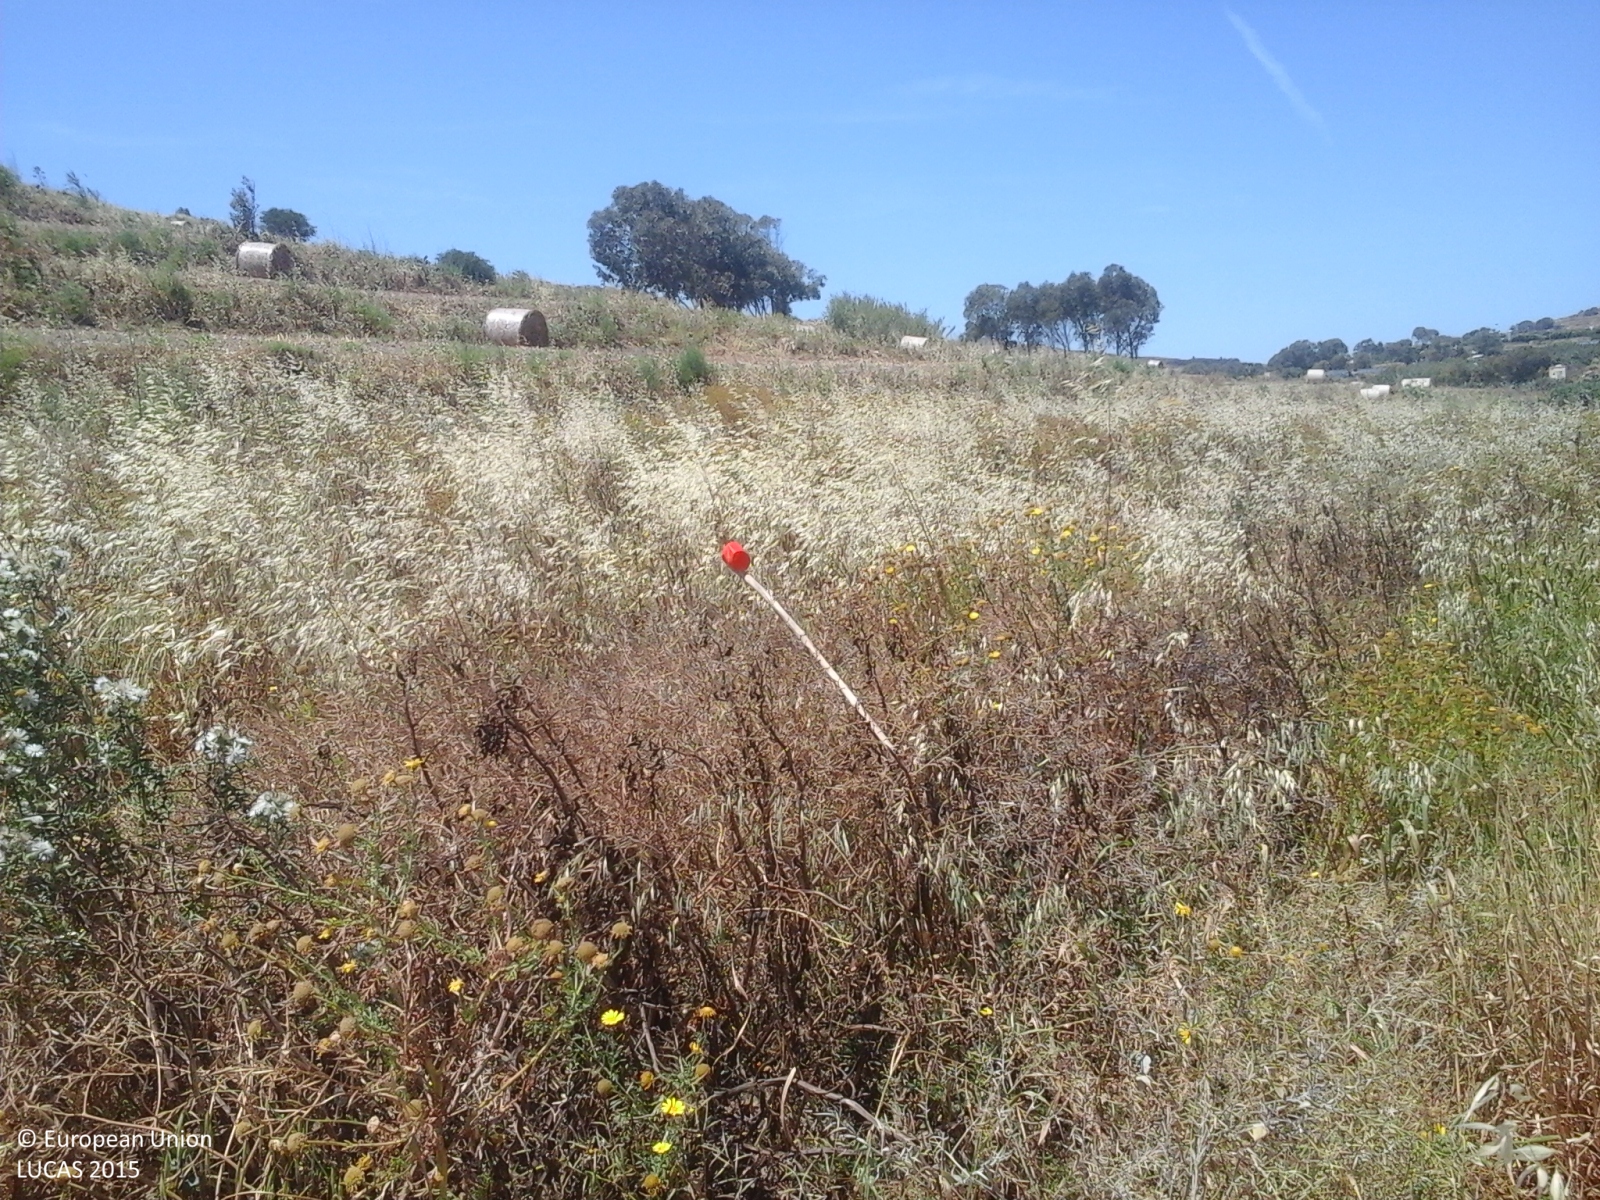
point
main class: Grassland
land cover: Spontaneously vegetated surfaces
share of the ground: > 75 %
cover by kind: herbaceous plants 100 %
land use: Agriculture (excluding fallow land and kitchen gardens)
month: May
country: MT
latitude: 36.0521
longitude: 14.2352
